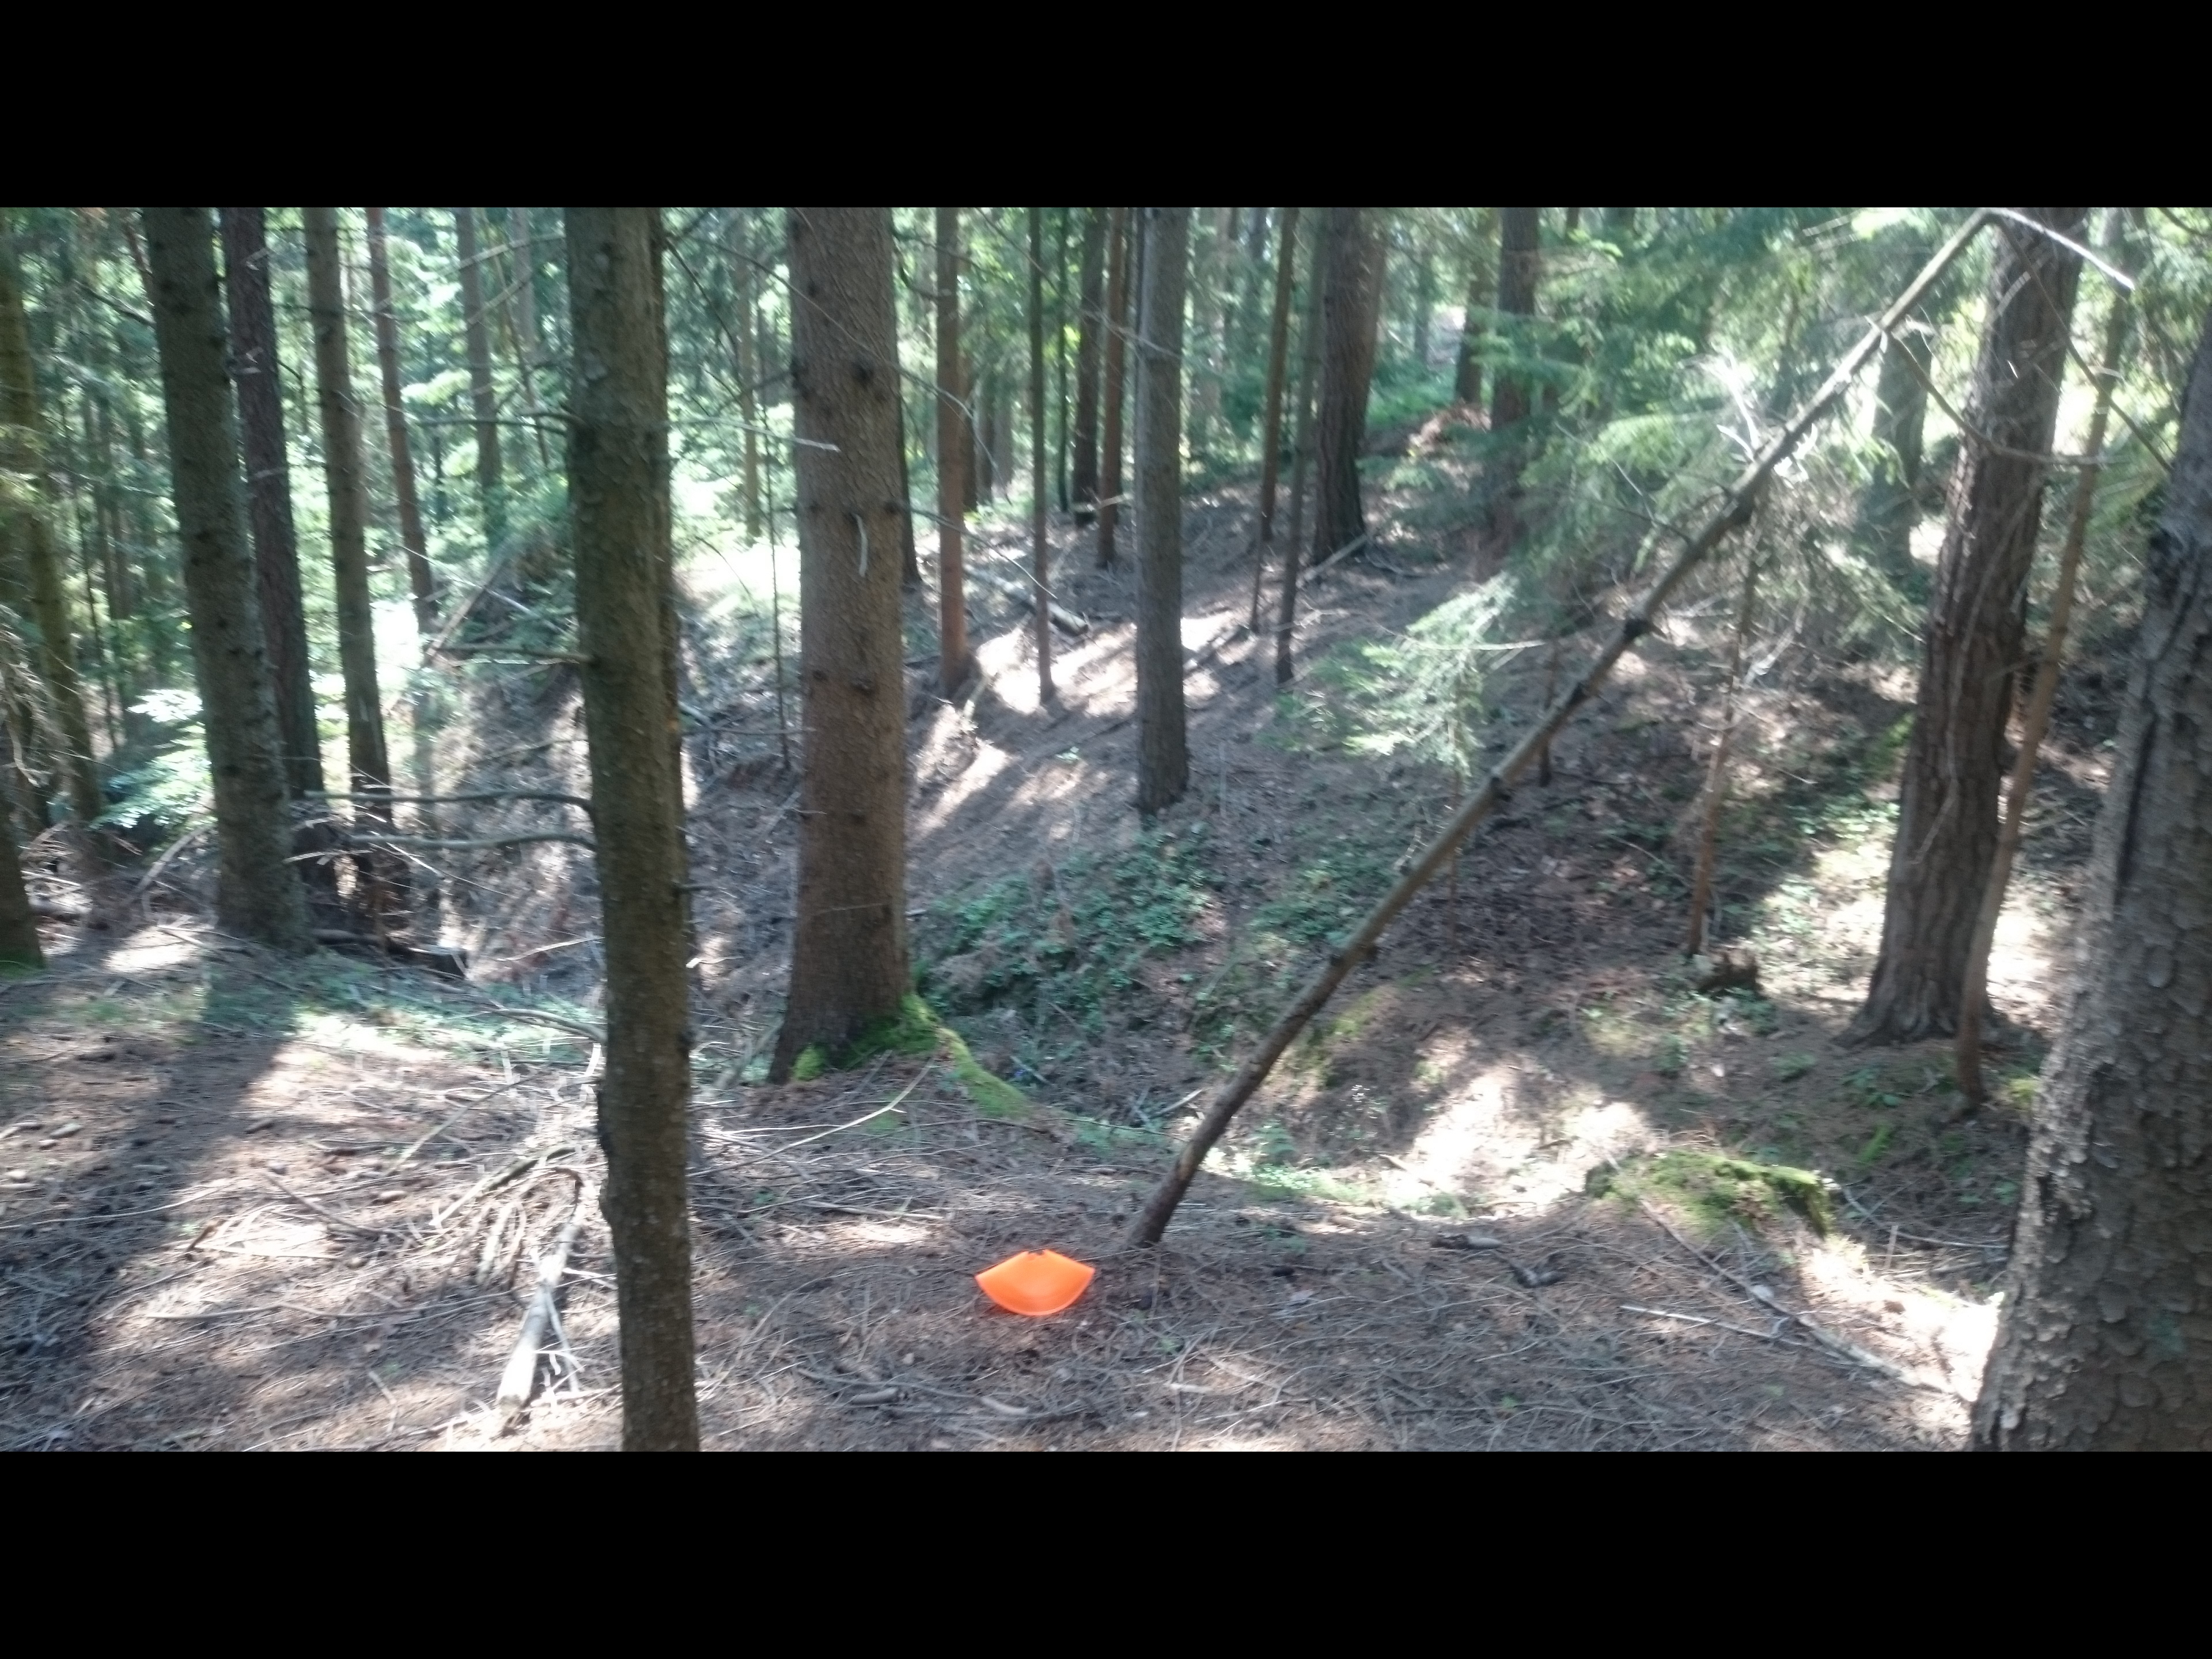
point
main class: Woodland
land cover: Spruce dominated coniferous woodland
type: hemiboreal forest and nemoral coniferous forest and mixed broadleaved-coniferous forest
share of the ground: > 75 %
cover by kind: coniferous forest trees 90 %, consolidated bare surface 10 %
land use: Forestry
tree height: > 5 m
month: July
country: AT
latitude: 47.2021
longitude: 15.5051
